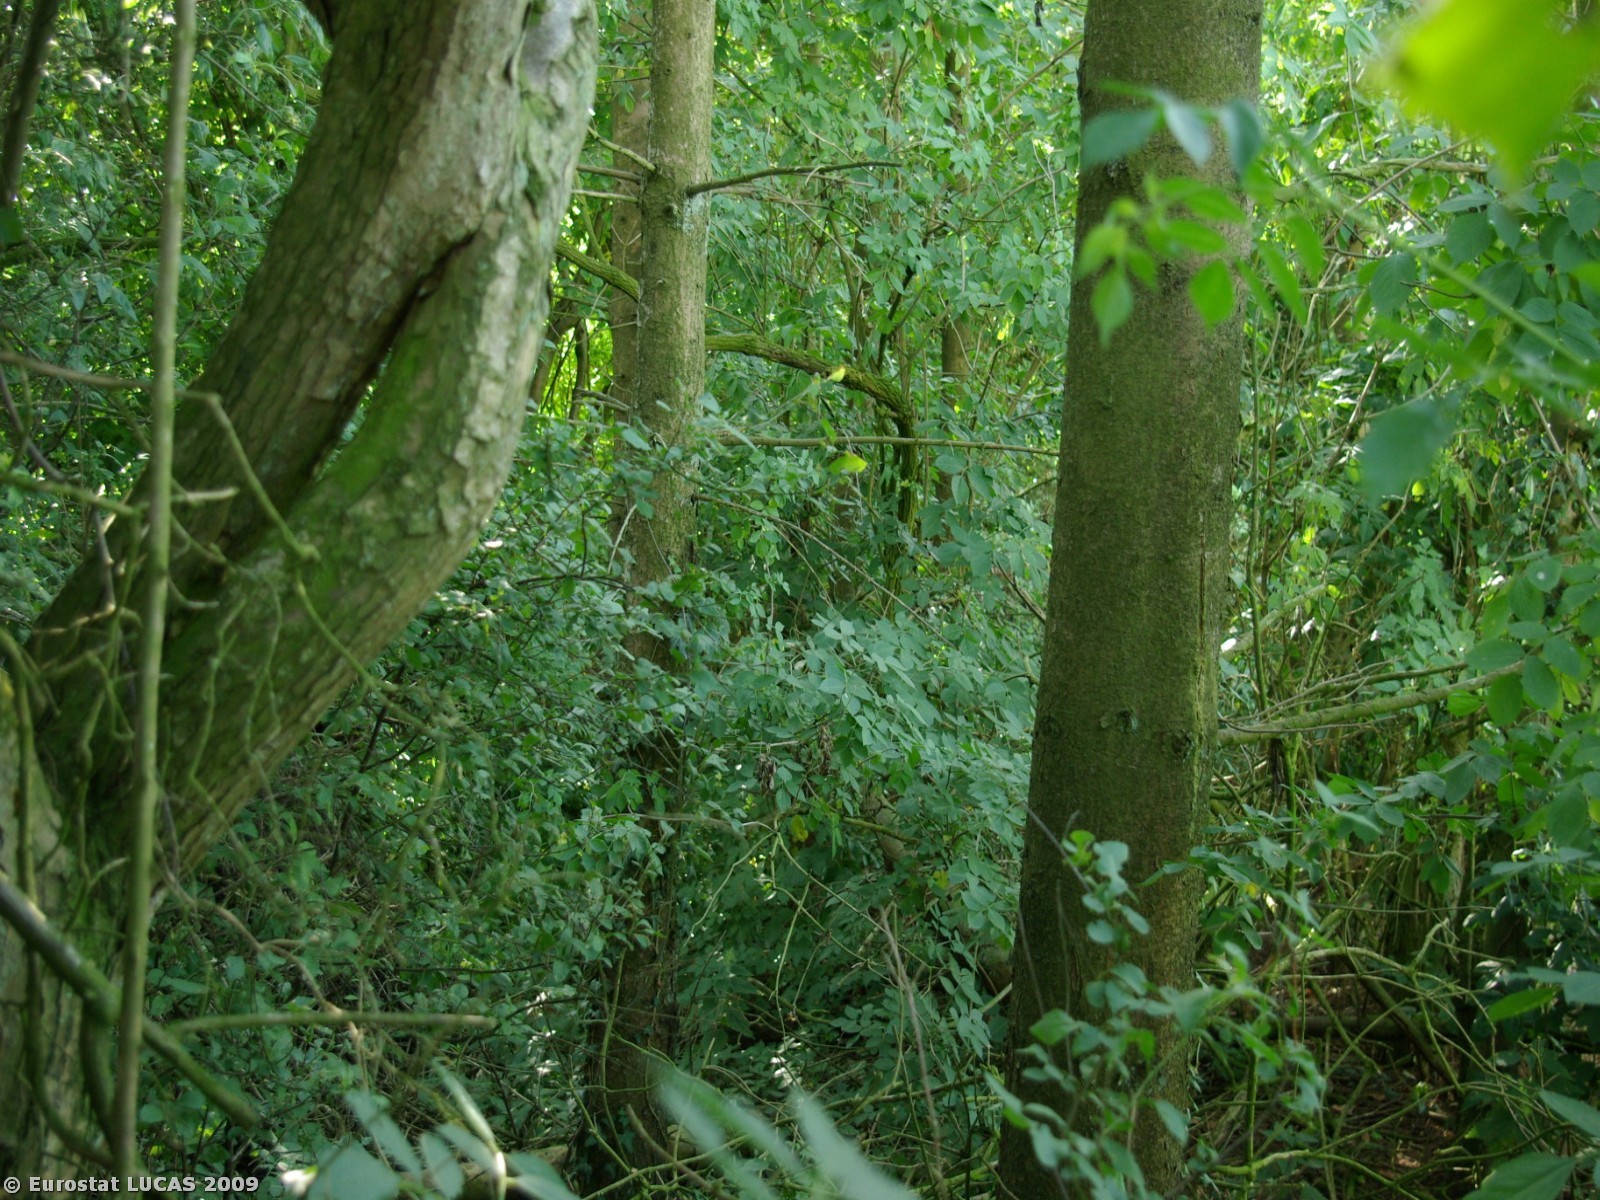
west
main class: Woodland
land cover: Mixed woodland
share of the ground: > 75 %
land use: Unused
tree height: > 5 m
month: July
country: DK
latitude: 54.9815
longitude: 9.2974
